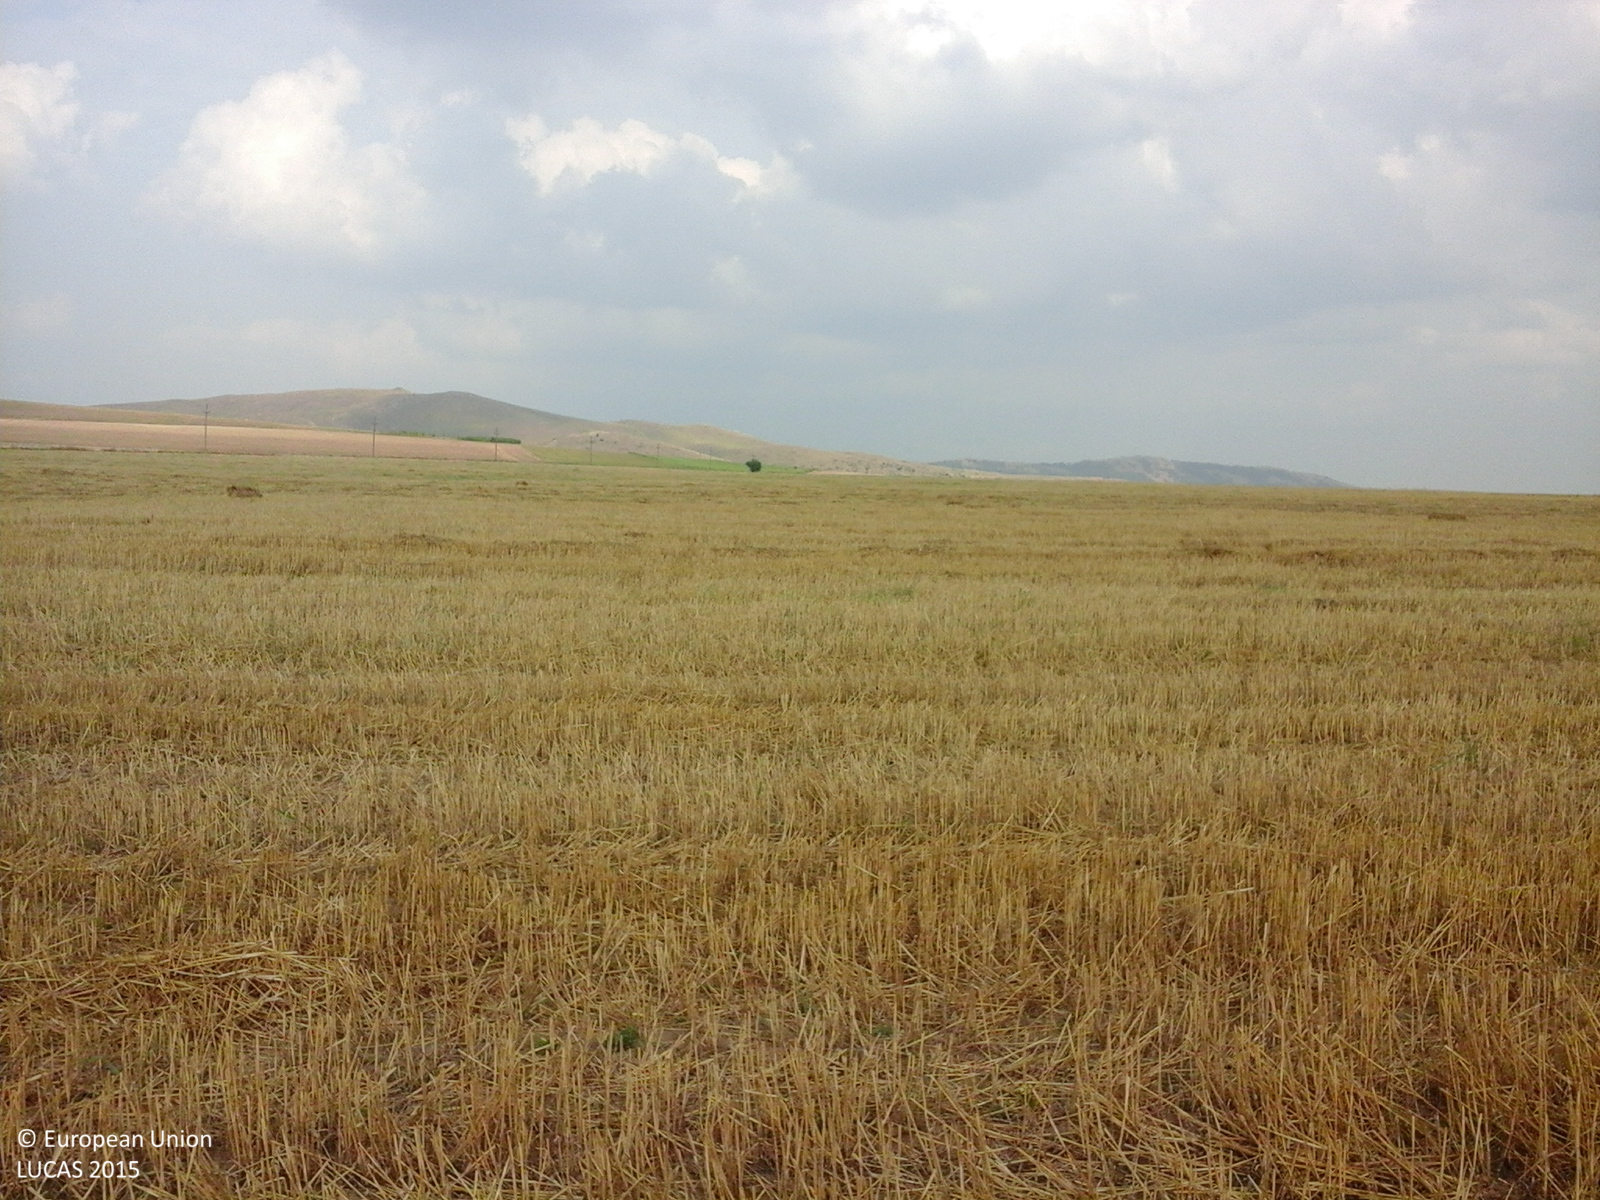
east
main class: Cropland
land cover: Common wheat
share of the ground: > 75 %
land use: Agriculture (excluding fallow land and kitchen gardens)
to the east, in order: Common wheat
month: July
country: RO
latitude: 45.0642
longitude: 28.4279
